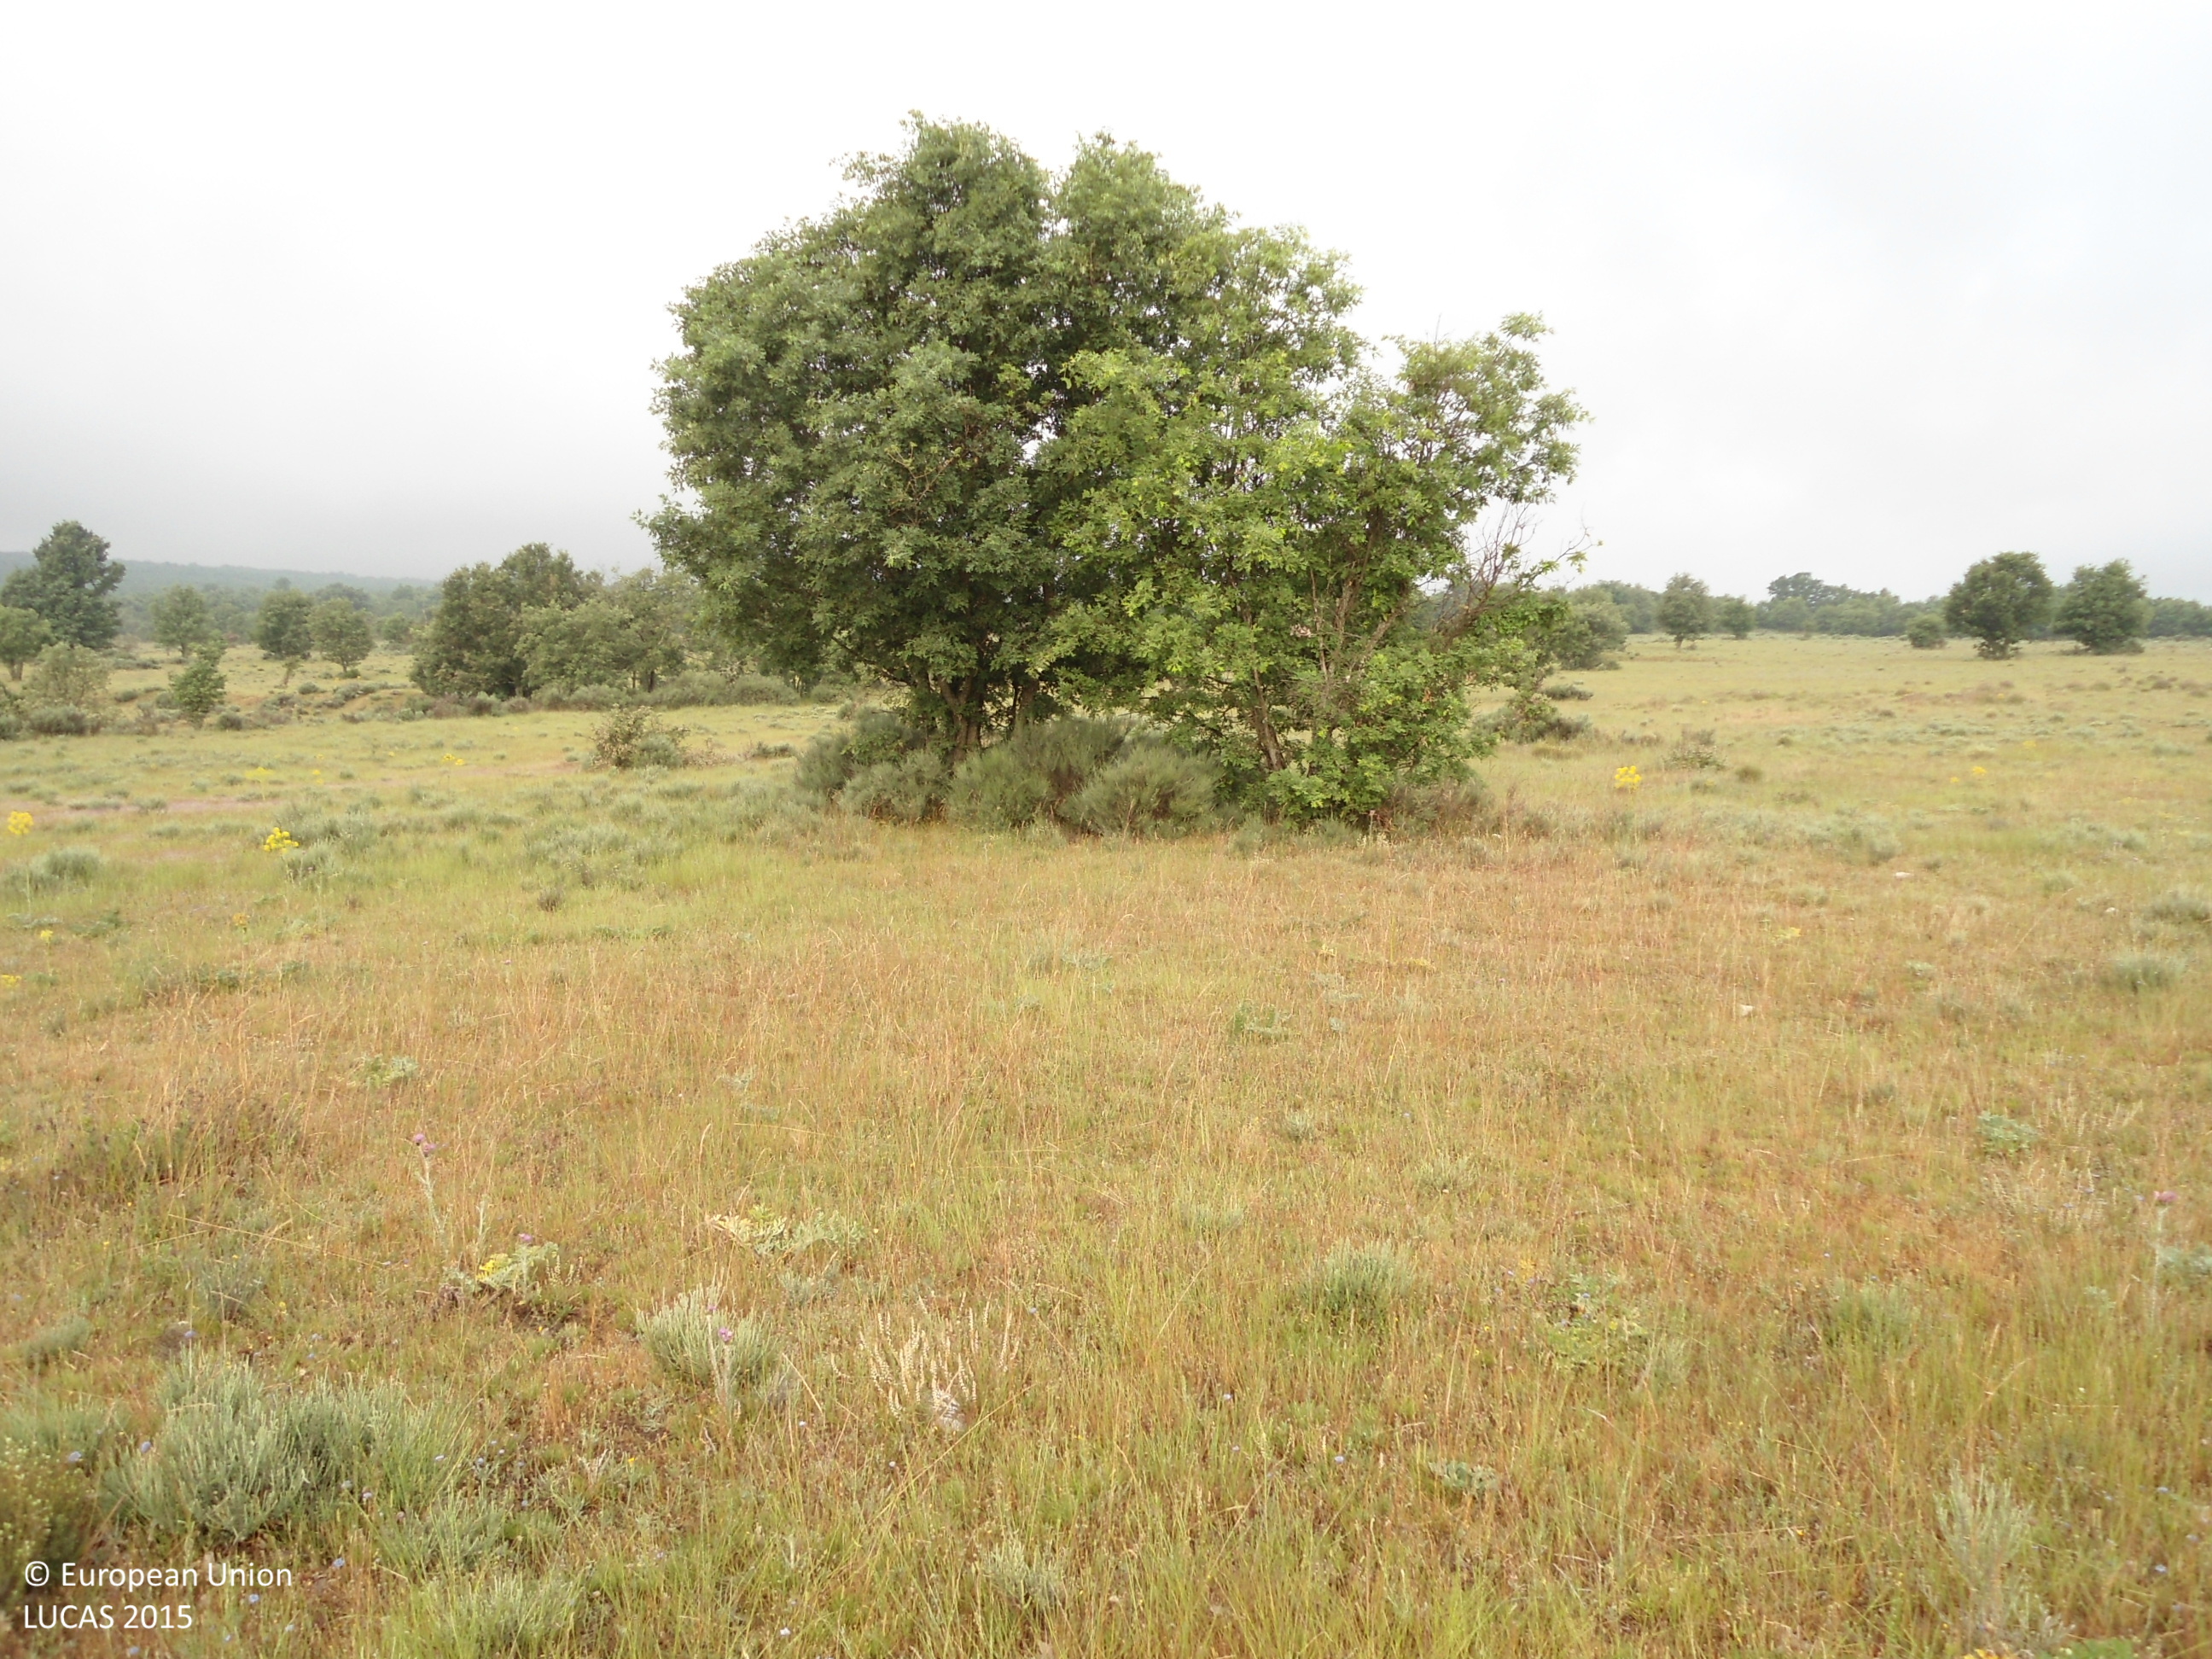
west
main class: Grassland
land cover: Grassland with sparse tree/shrub cover
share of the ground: > 75 %
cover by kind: herbaceous plants 85 %, shrubs 10 %, broadleaved forest trees 5 %
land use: Agriculture (excluding fallow land and kitchen gardens)
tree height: > 5 m
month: June
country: ES
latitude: 42.0531
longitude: -6.3340
